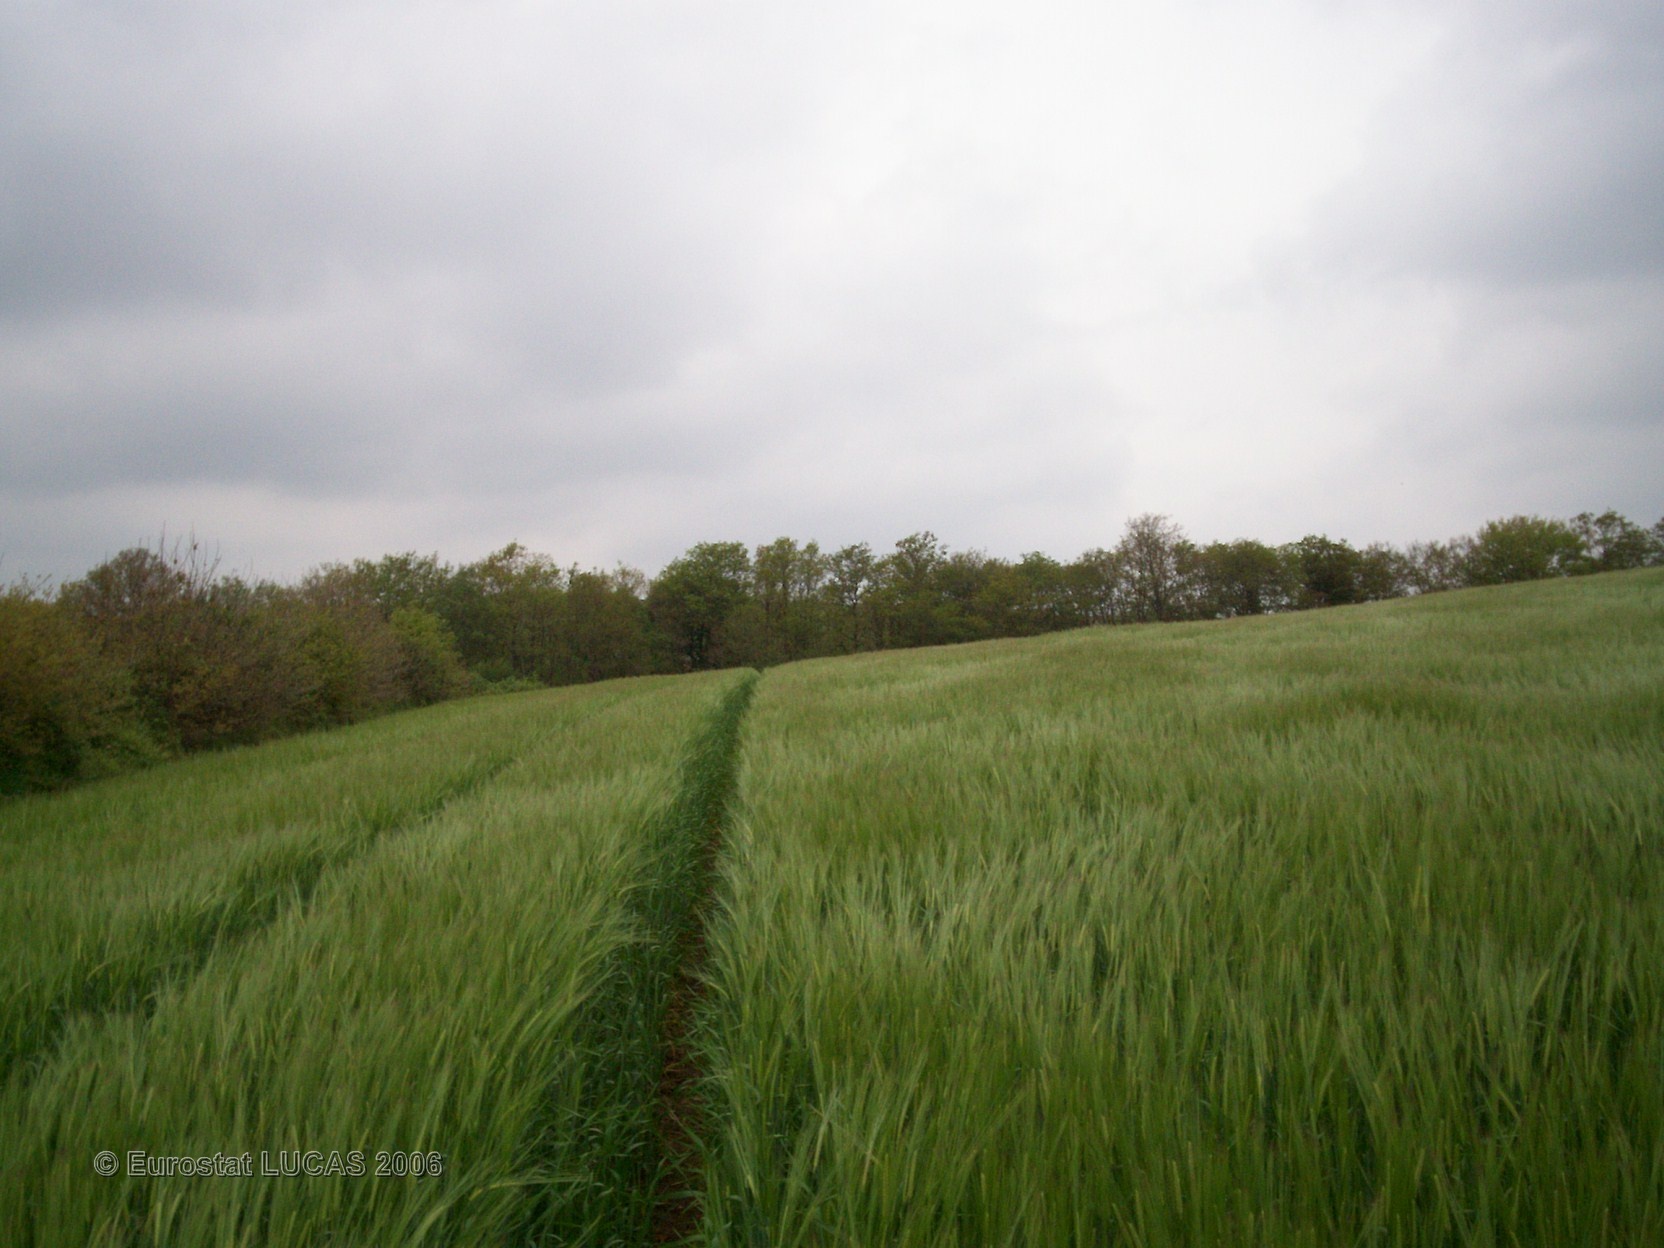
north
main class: Cropland
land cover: Barley
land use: Agriculture (excluding fallow land and kitchen gardens)
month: May
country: FR
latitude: 48.2575
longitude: -3.6994
